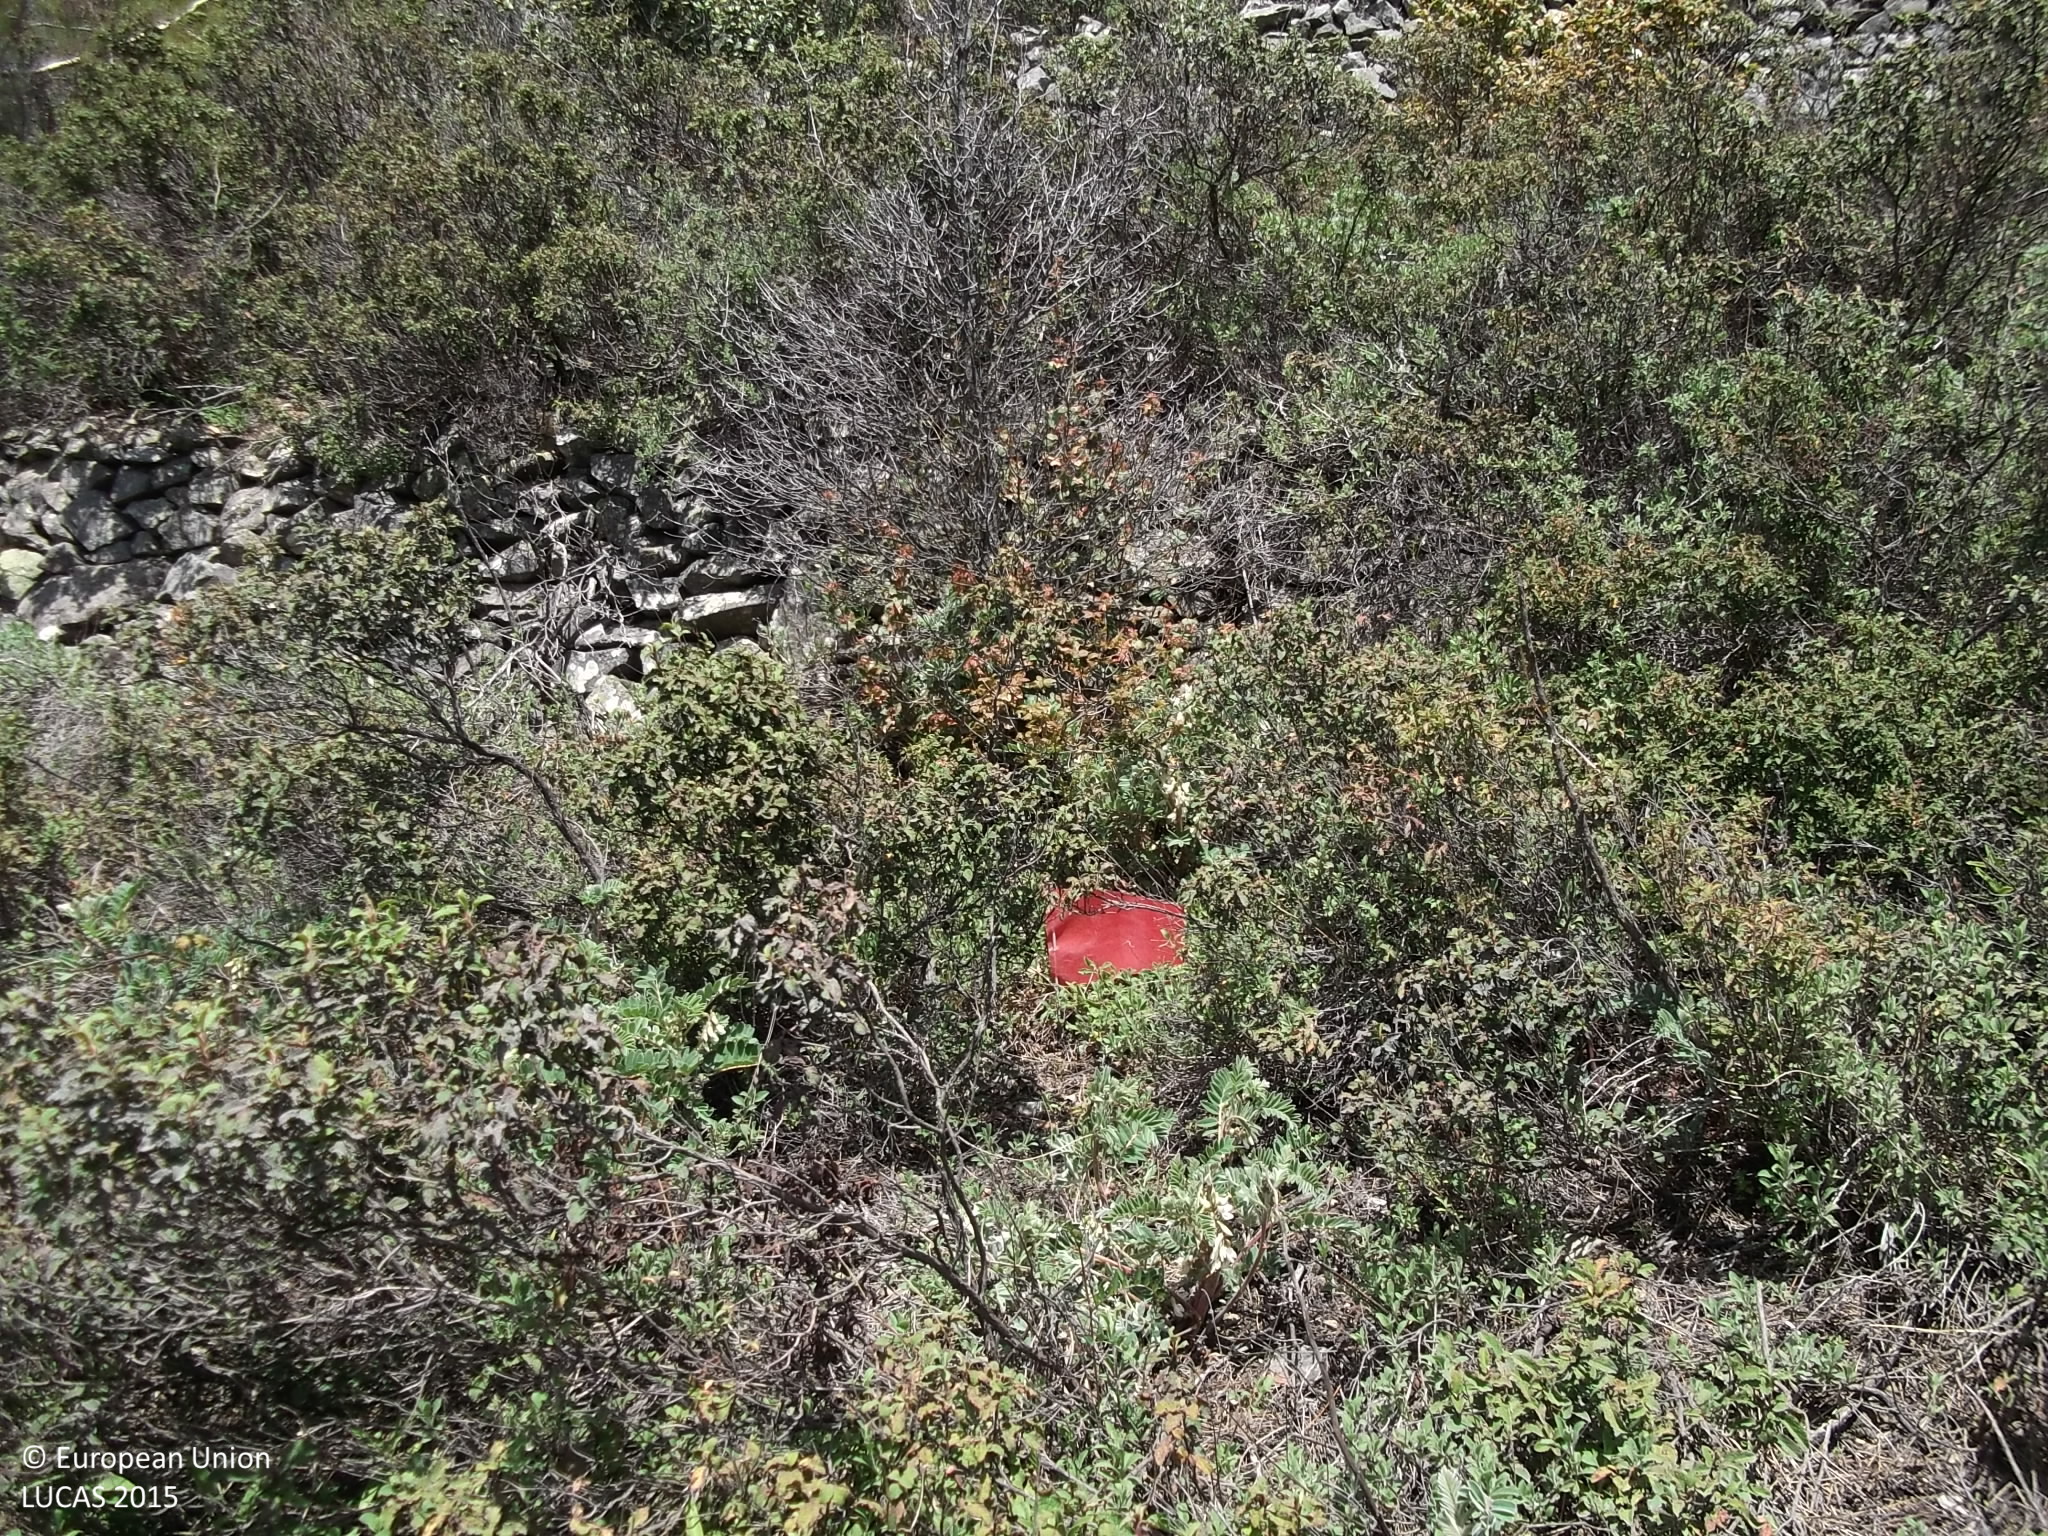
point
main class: Woodland
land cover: Pine dominated mixed woodland
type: coniferous forest of the mediterranean region
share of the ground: 25 - 50 %
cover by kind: shrubs 40 %, coniferous forest trees 35 %, broadleaved forest trees 15 %, consolidated bare surface 5 %, unconsolidated bare surface 5 %
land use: Semi-natural and natural areas not in use
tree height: > 5 m
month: April
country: CY
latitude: 34.9124
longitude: 33.1962
